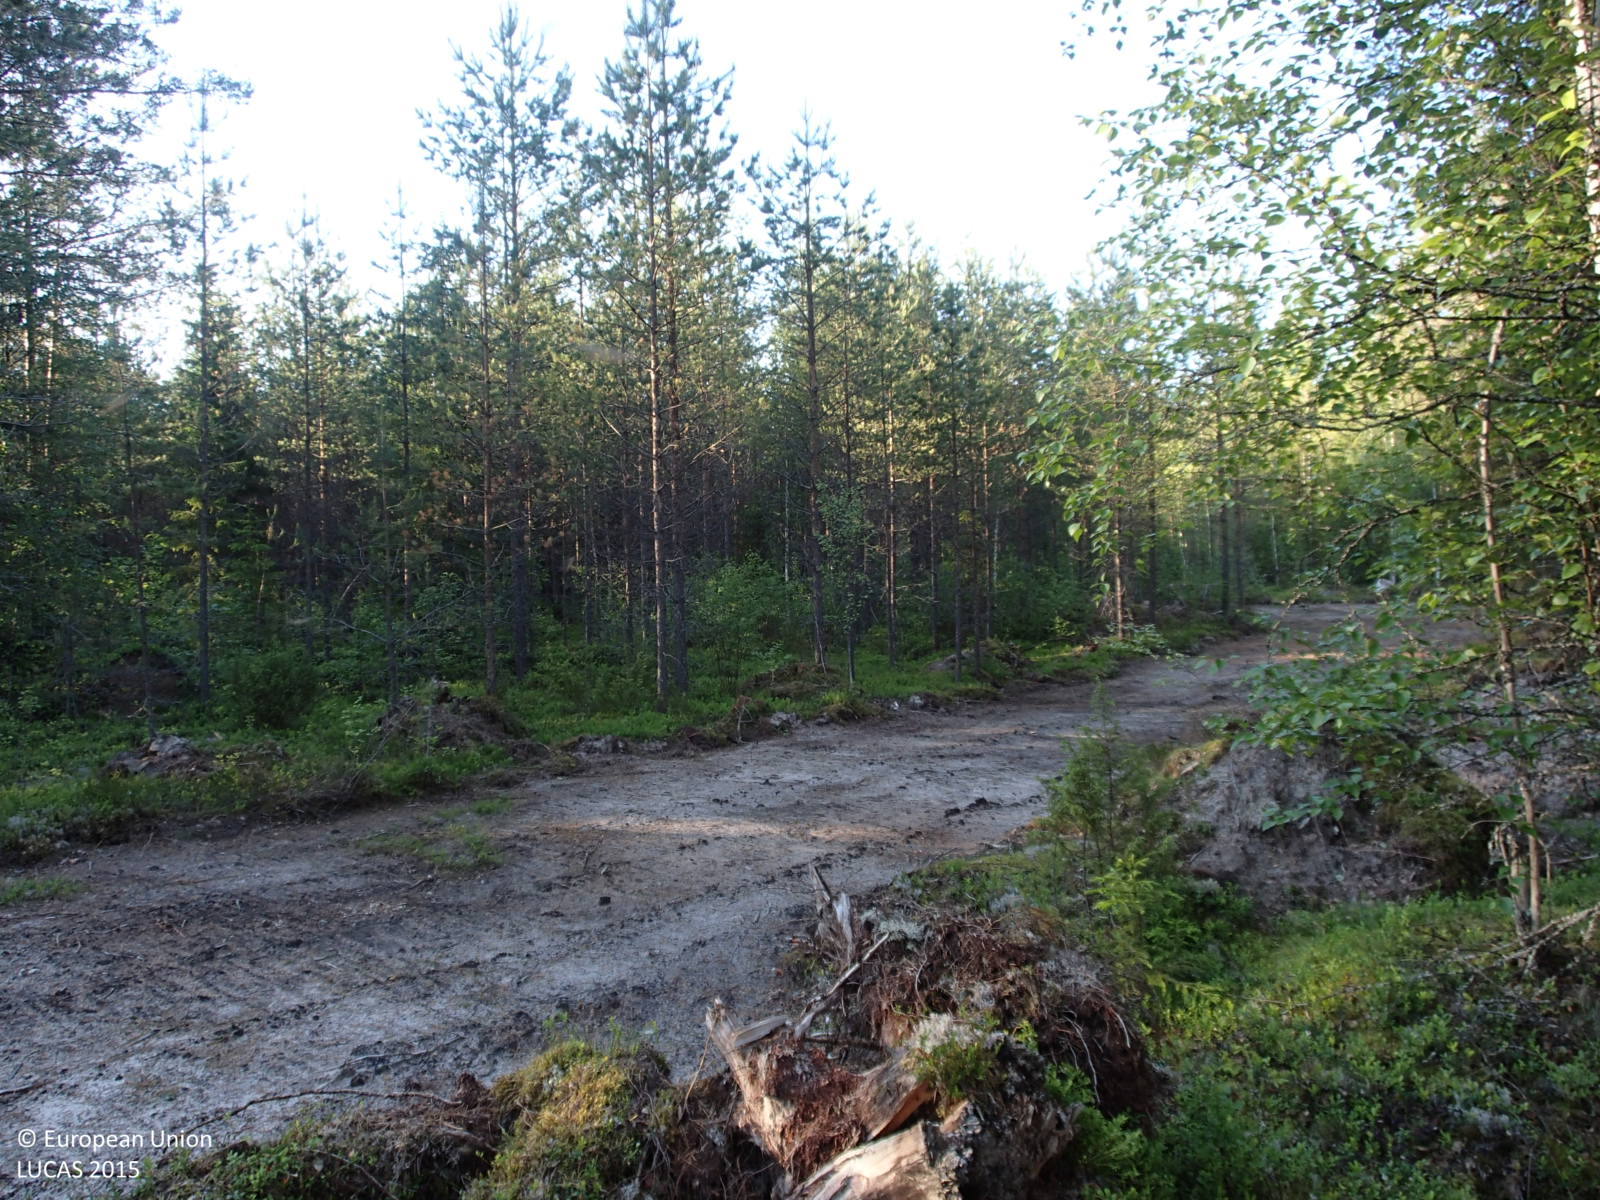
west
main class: Woodland
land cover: Pine dominated coniferous woodland
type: boreal forest
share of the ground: 50 - 75 %
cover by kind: coniferous forest trees 55 %, shrubs 25 %, lichens and mosses 20 %
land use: Forestry
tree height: > 5 m
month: July
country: FI
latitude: 64.0470
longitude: 27.1578
